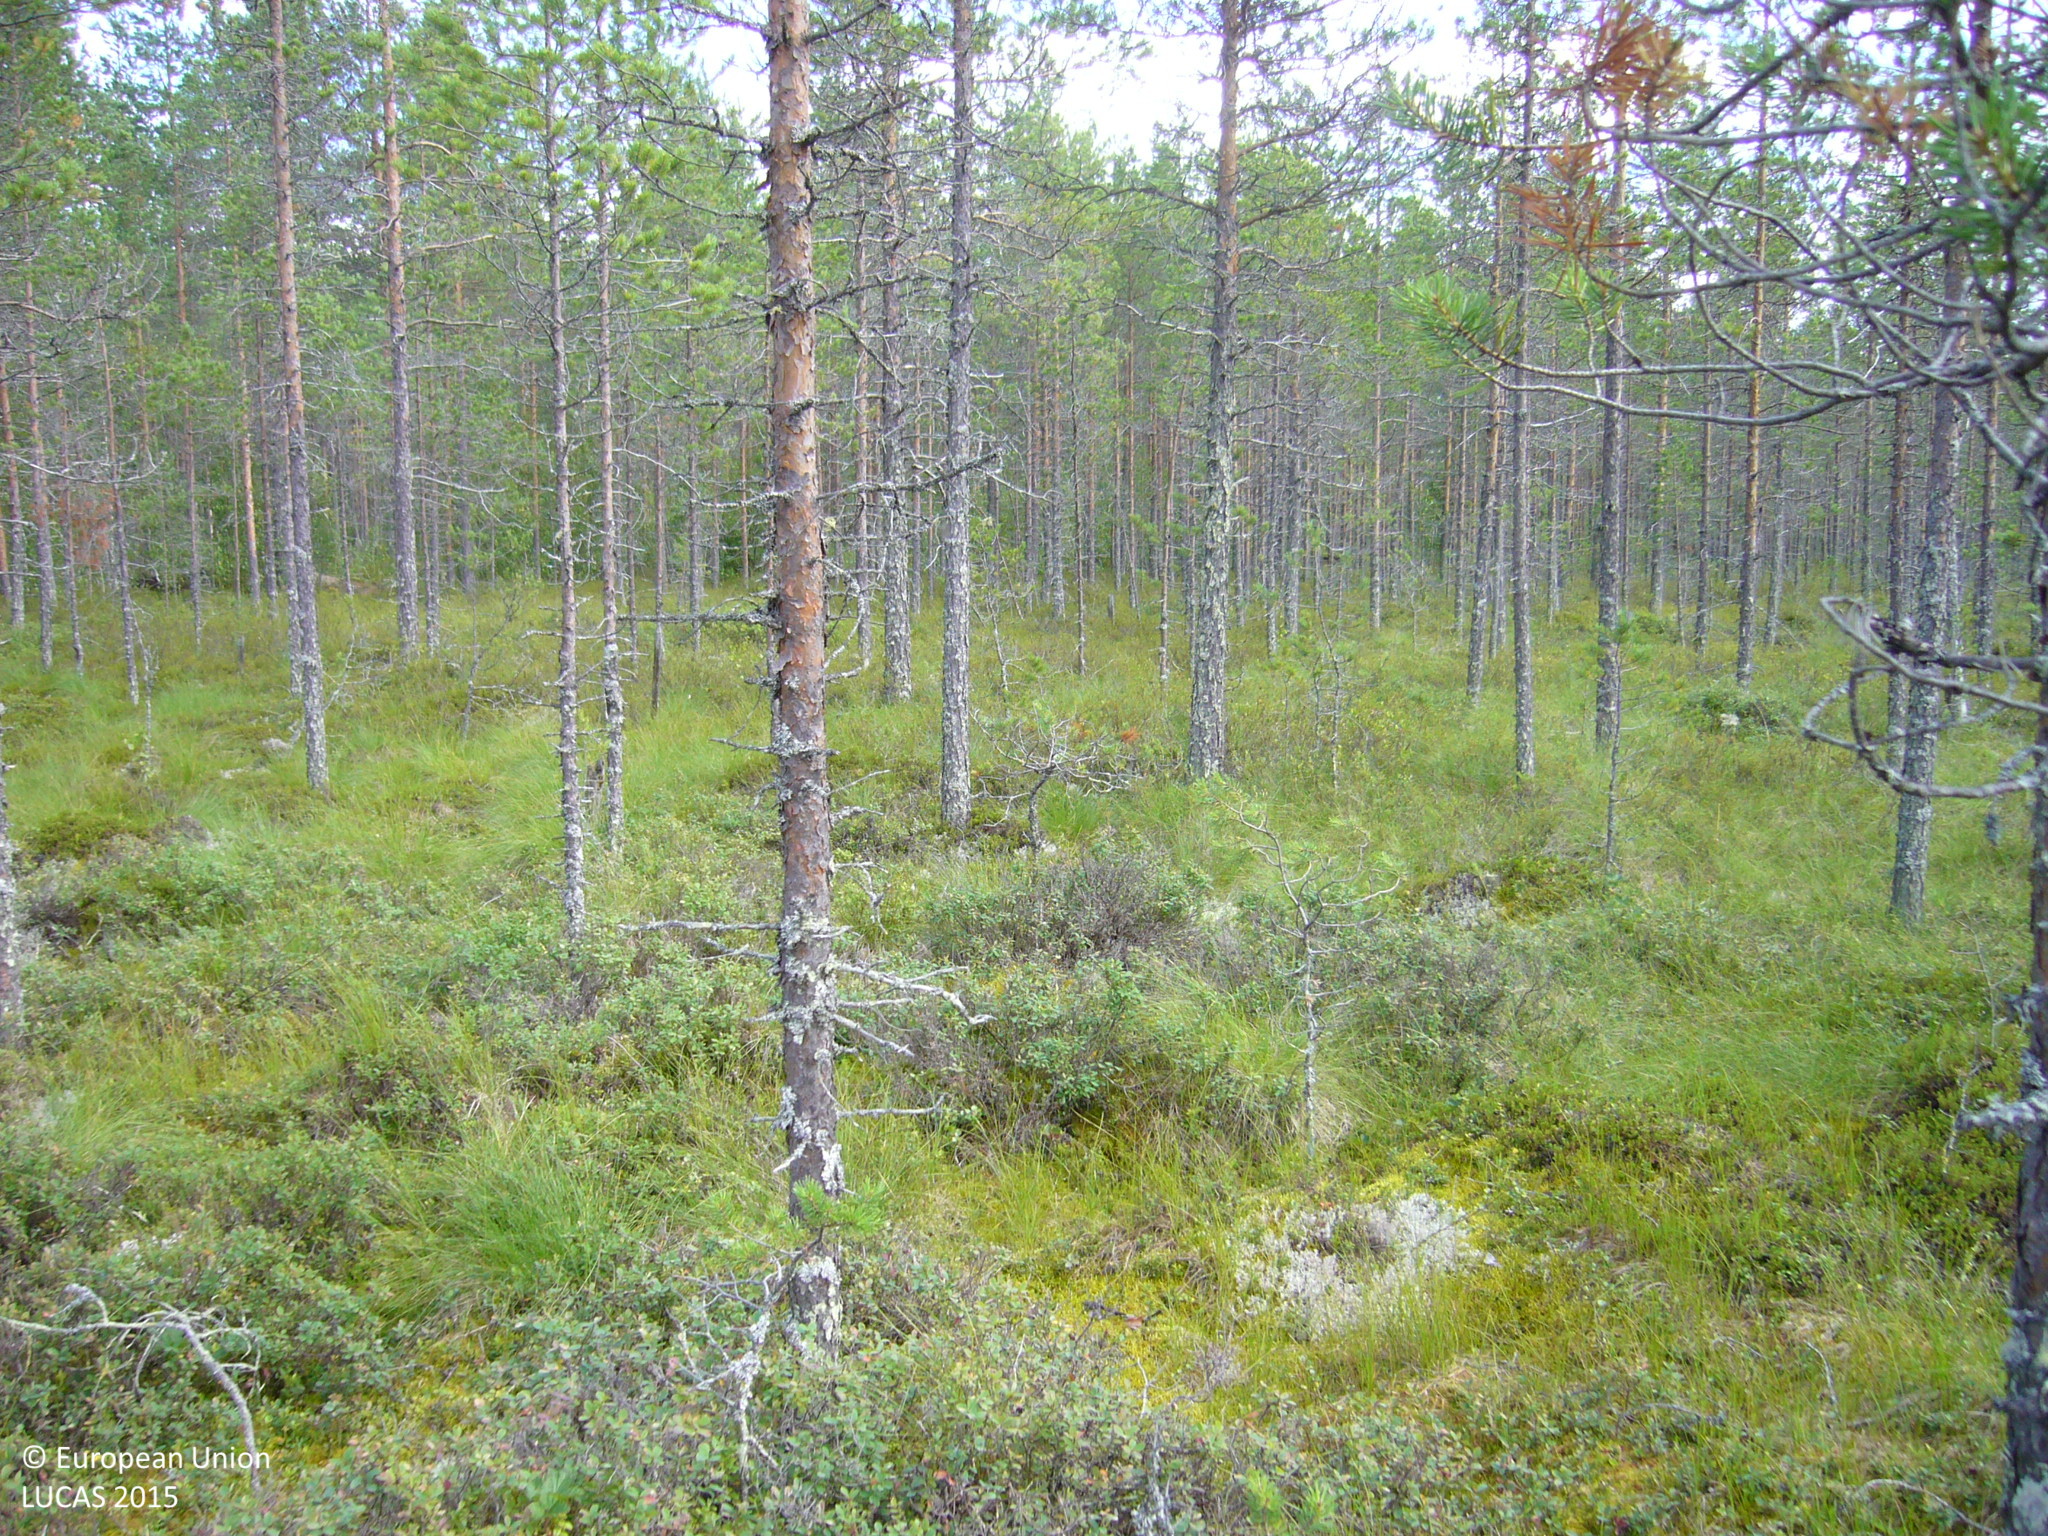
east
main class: Woodland
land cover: Pine dominated coniferous woodland
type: boreal forest
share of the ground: 50 - 75 %
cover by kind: coniferous forest trees 50 %, lichens and mosses 30 %, shrubs 20 %
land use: Forestry
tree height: > 5 m
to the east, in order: Pine dominated coniferous woodland; Ditches and canals; Pine dominated mixed woodland; Ditches and canals; Pine dominated mixed woodland; Ditches and canals; Pine dominated mixed woodland
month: July
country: FI
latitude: 64.1011
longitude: 26.1361
